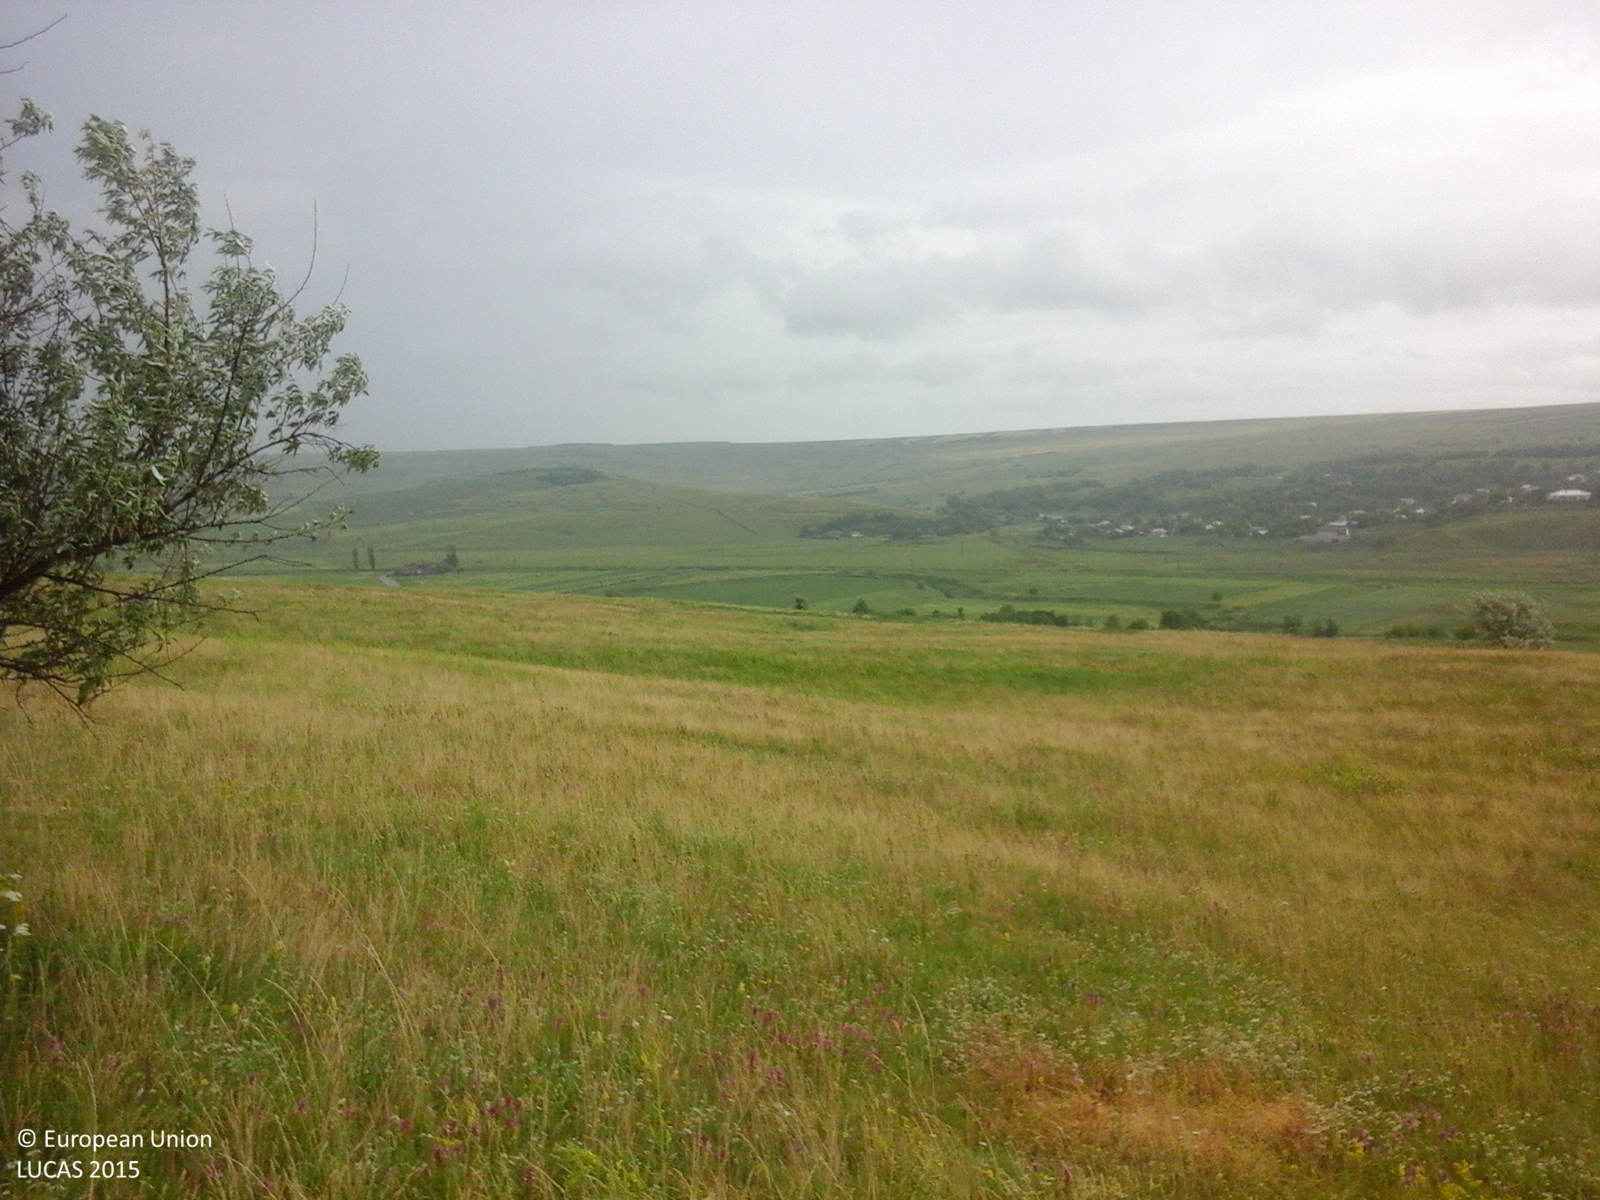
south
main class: Grassland
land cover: Grassland with sparse tree/shrub cover
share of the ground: > 75 %
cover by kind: herbaceous plants 90 %, broadleaved forest trees 5 %, shrubs 5 %
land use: Agriculture (excluding fallow land and kitchen gardens)
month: June
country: RO
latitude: 47.9273
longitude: 26.5966
